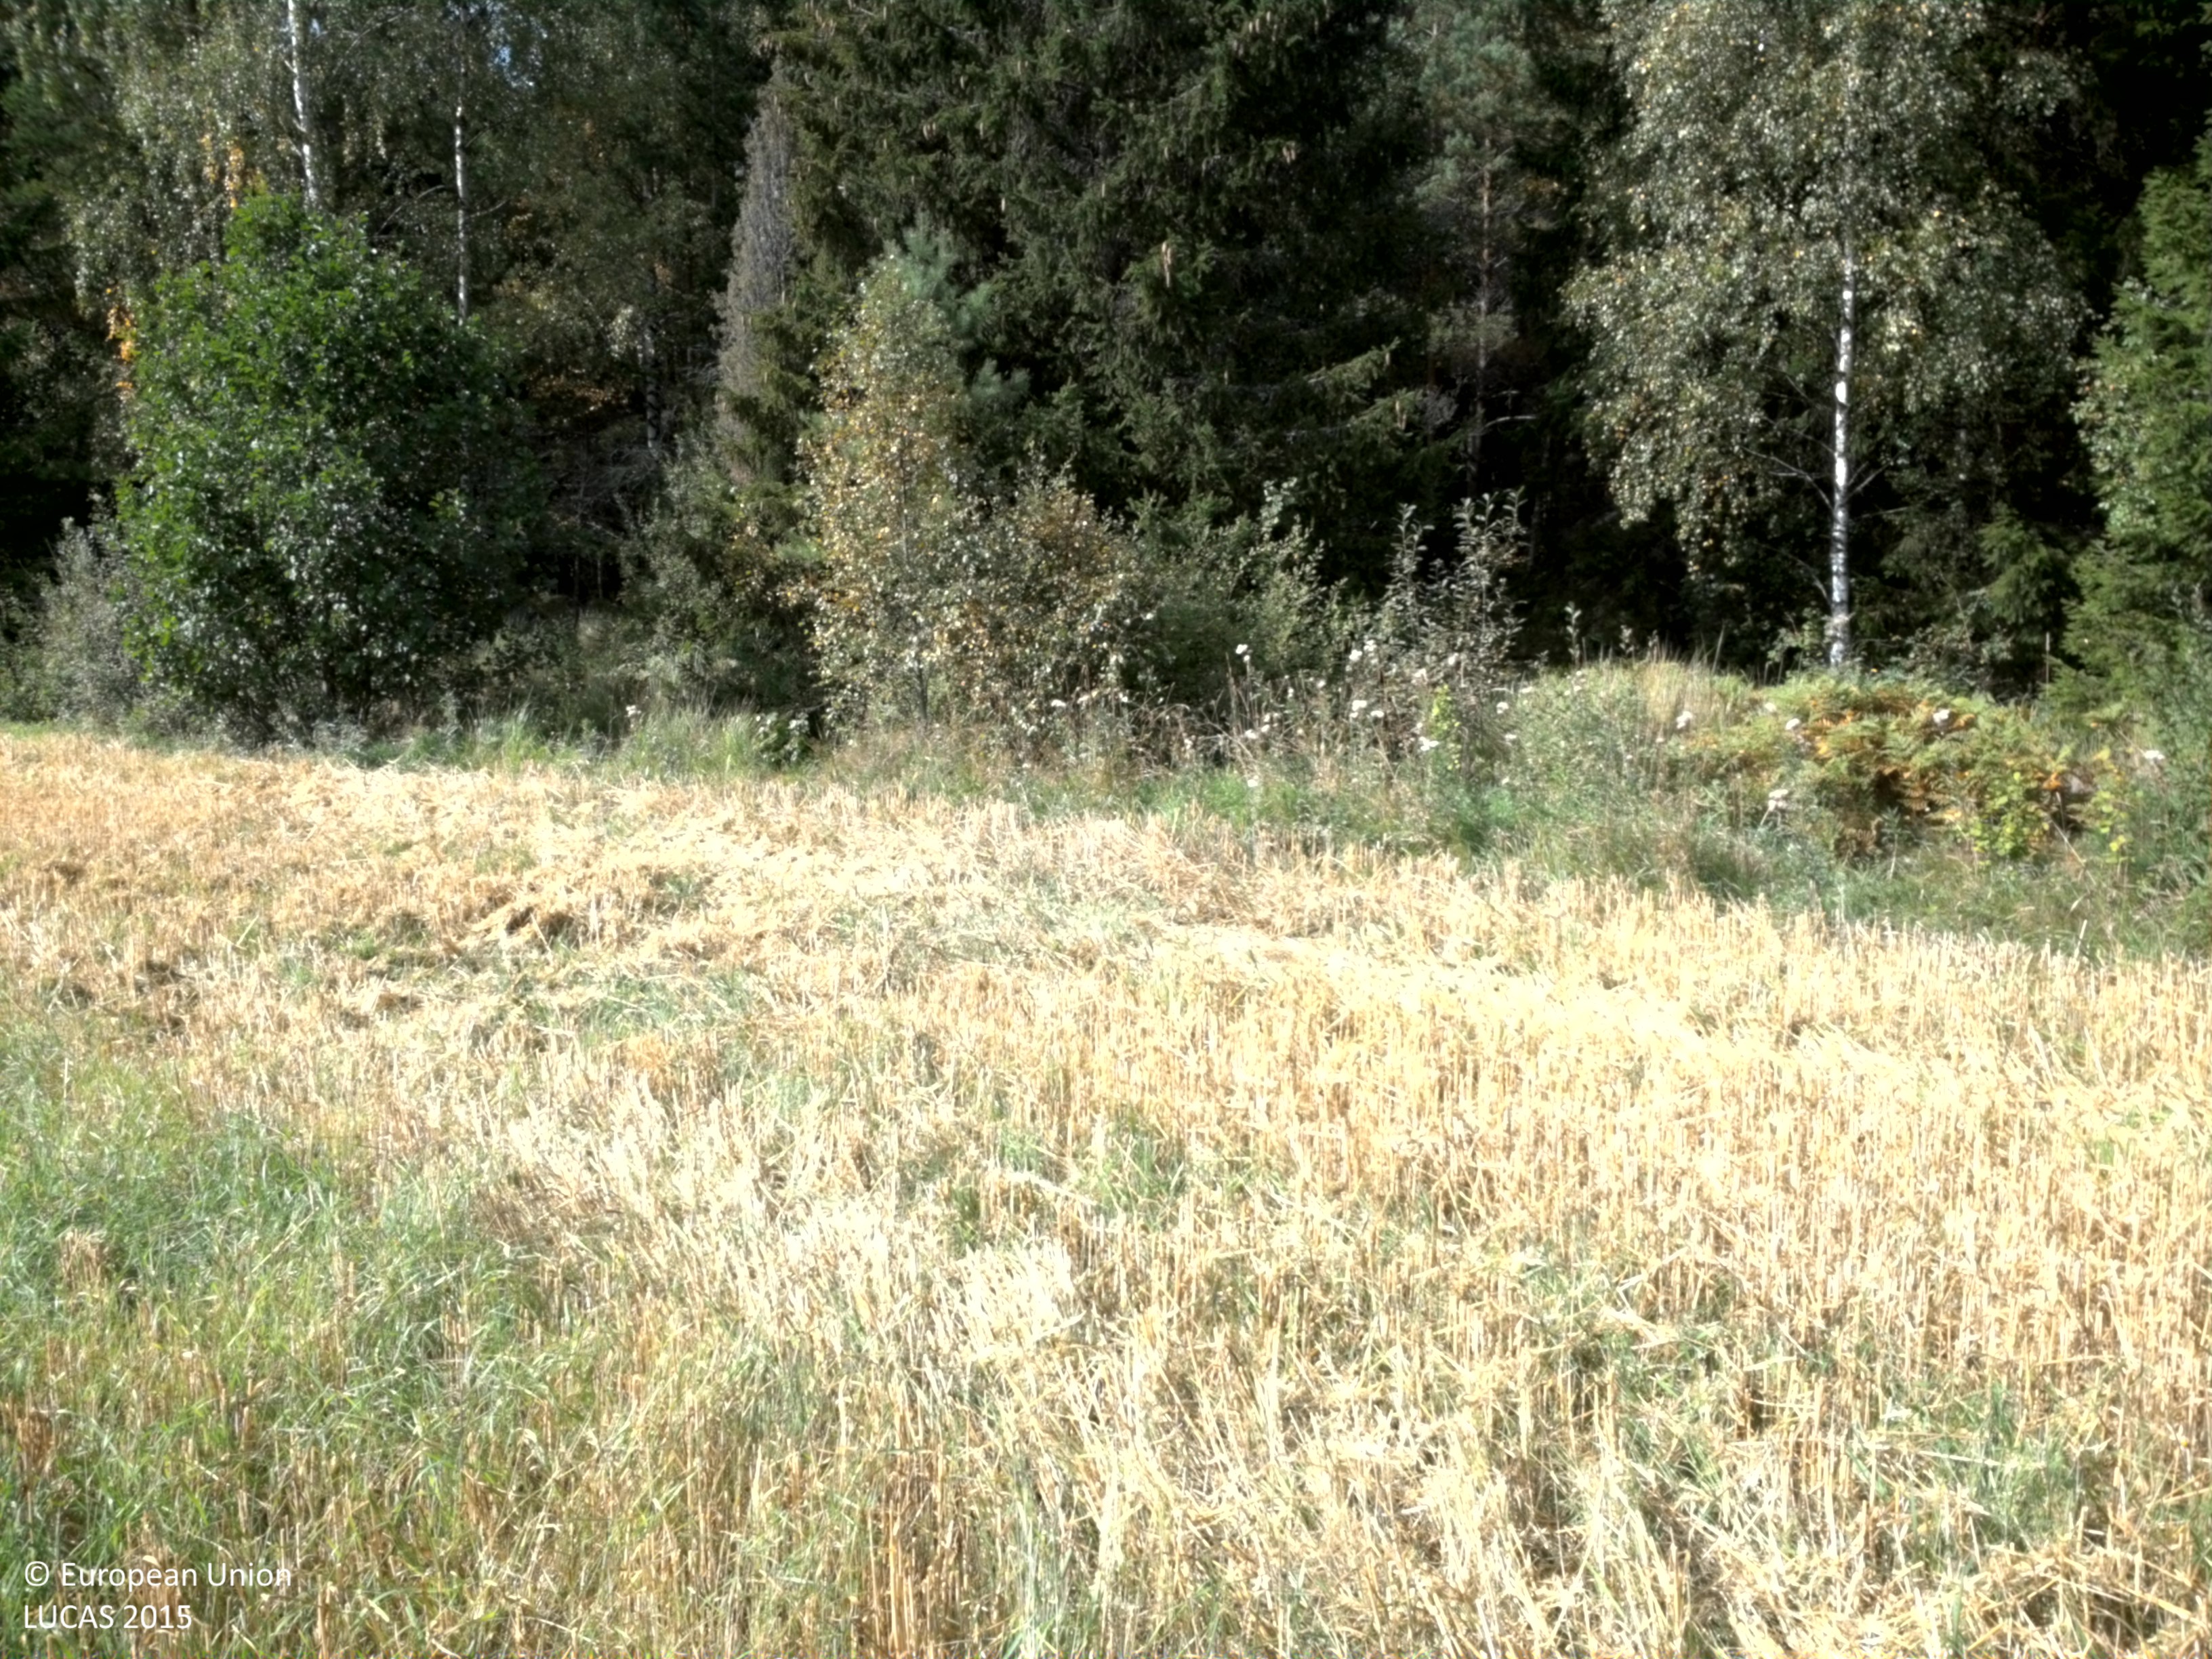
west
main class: Cropland
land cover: Common wheat
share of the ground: 50 - 75 %
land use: Agriculture (excluding fallow land and kitchen gardens)
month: August
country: SE
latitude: 59.6041
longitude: 17.0989
